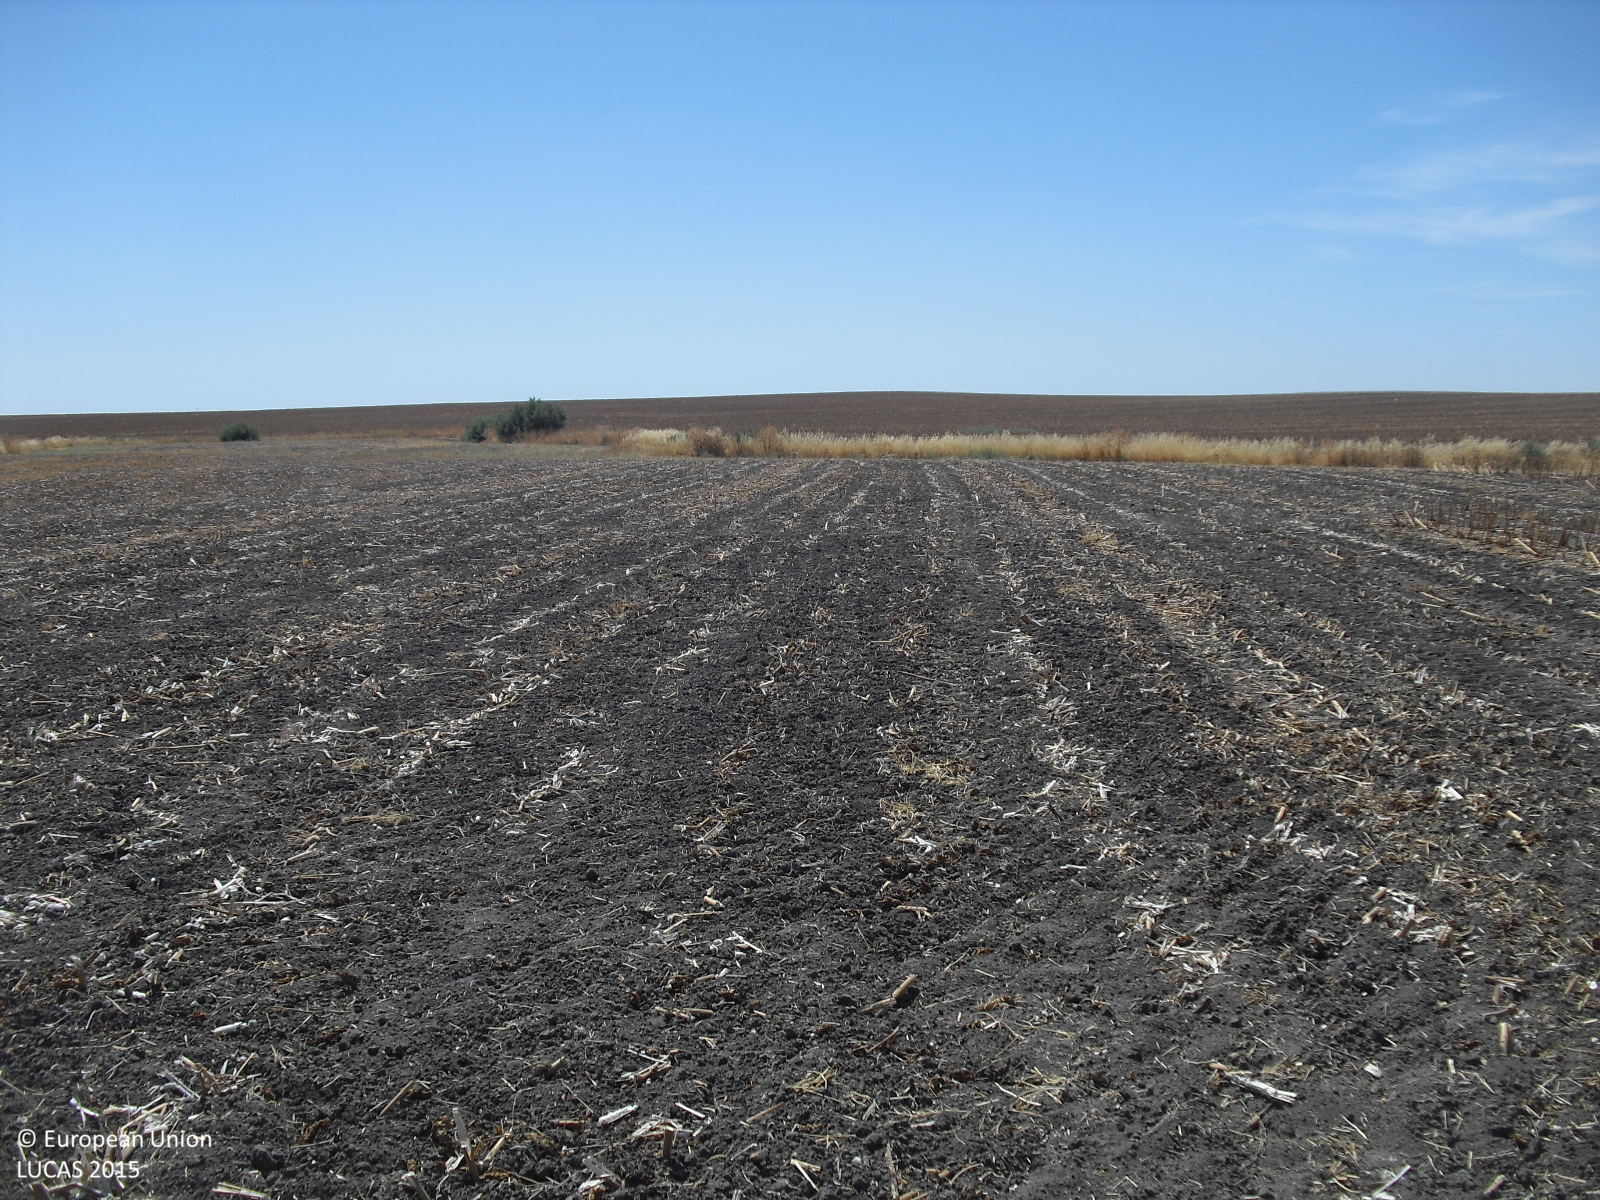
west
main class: Cropland
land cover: Sunflower
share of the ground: < 10 %
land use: Agriculture (excluding fallow land and kitchen gardens)
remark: Harvested field
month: August
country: ES
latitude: 37.3604
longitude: -5.5634
